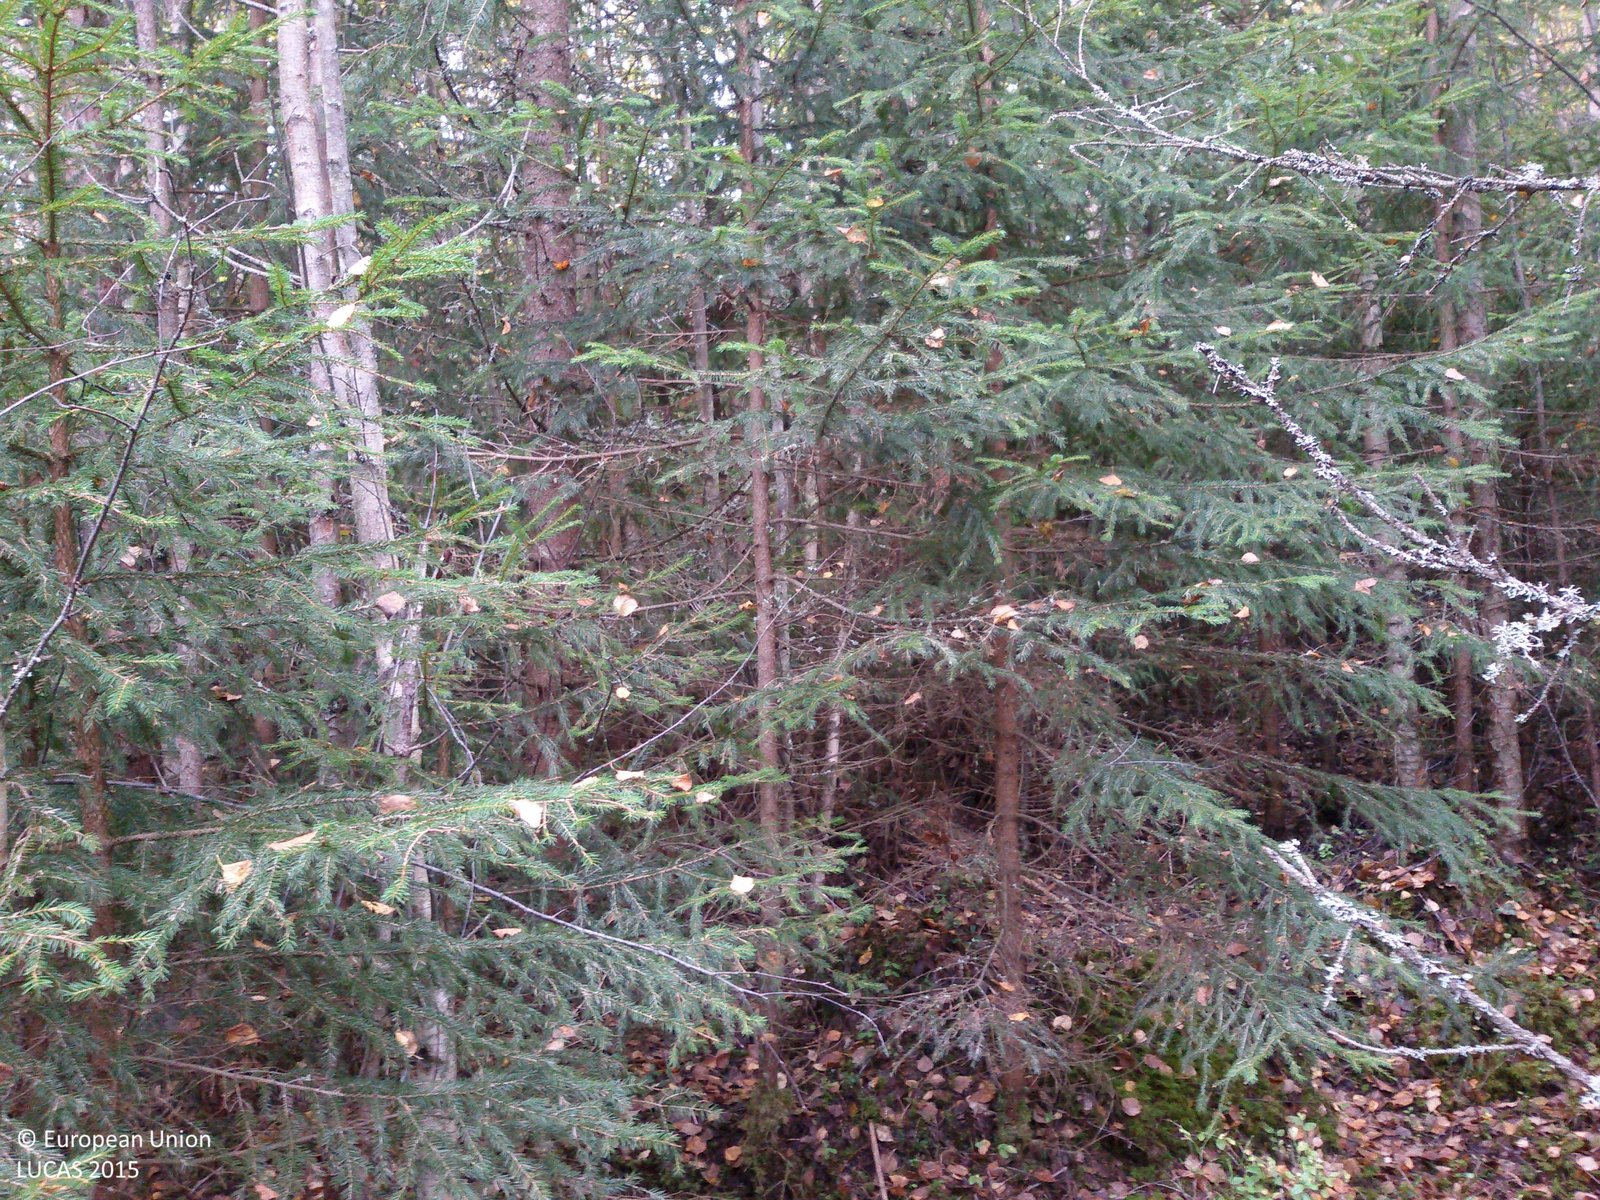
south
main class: Woodland
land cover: Spruce dominated mixed woodland
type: boreal forest
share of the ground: > 75 %
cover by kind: coniferous forest trees 50 %, broadleaved forest trees 50 %
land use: Forestry
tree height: > 5 m
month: September
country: SE
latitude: 60.7469
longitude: 14.8485
